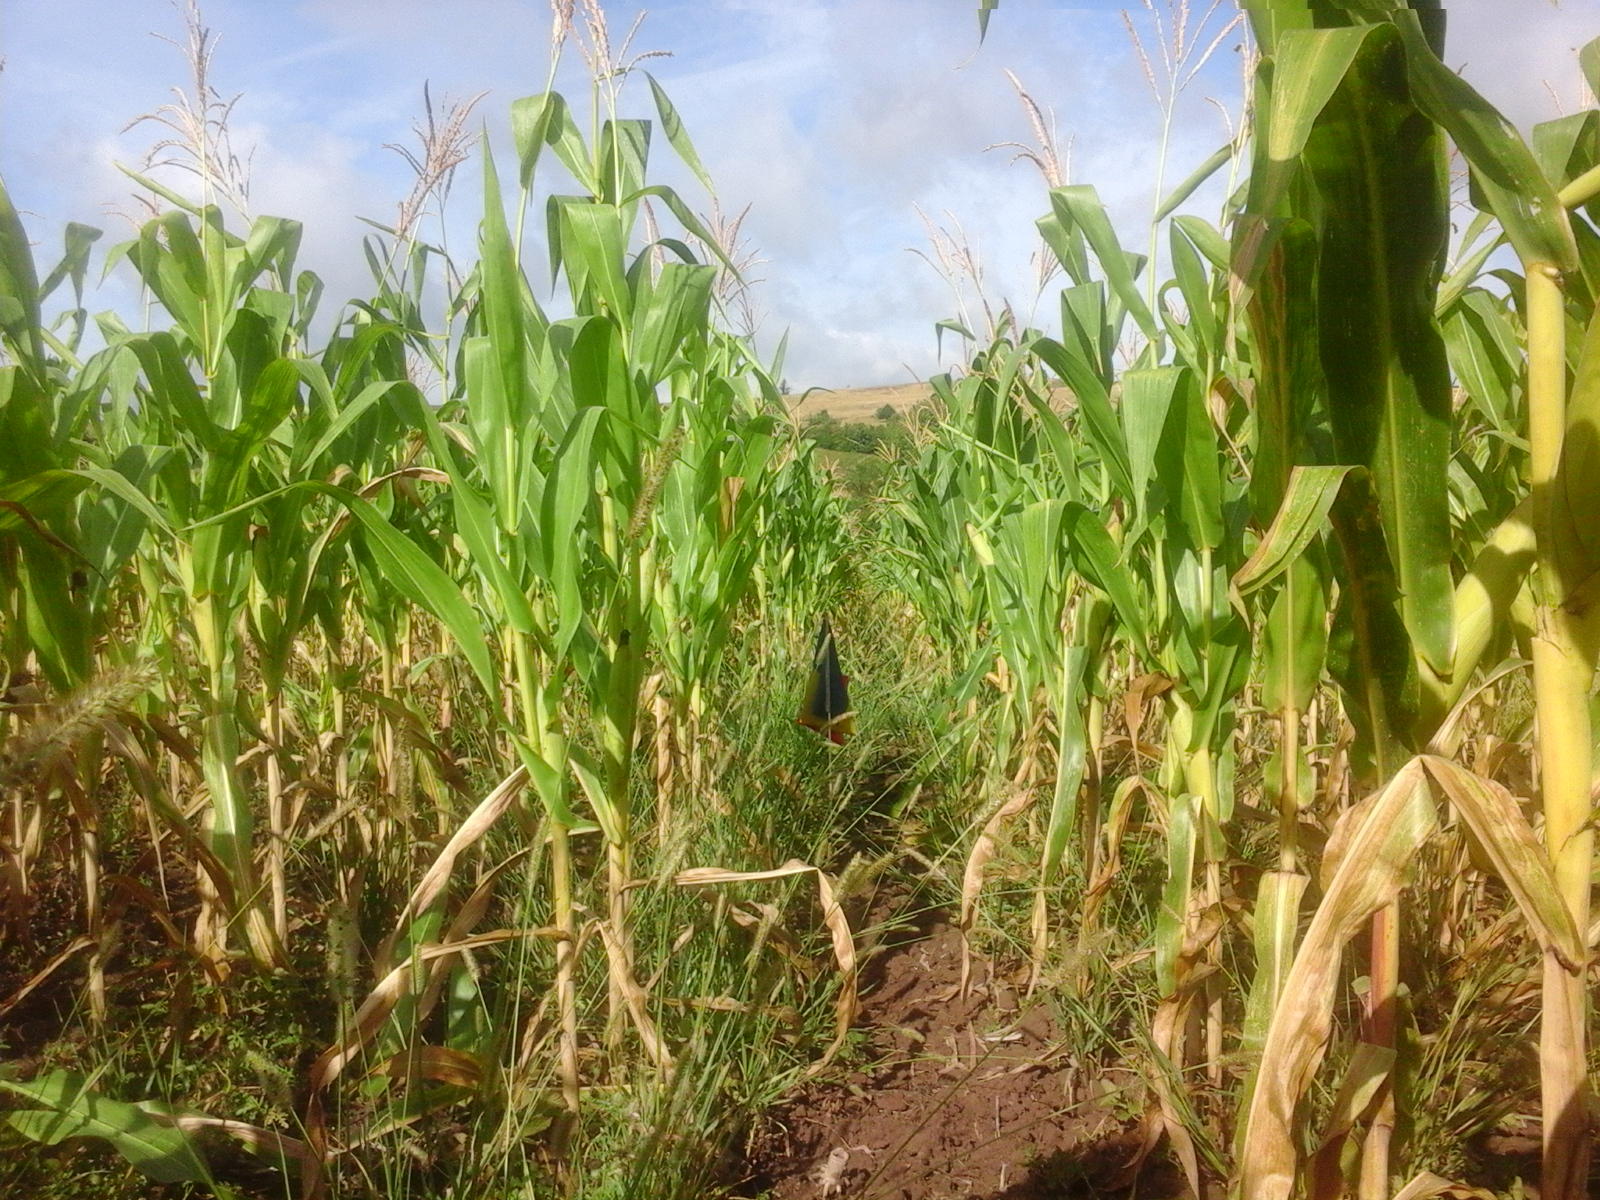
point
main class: Cropland
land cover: Maize
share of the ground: > 75 %
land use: Agriculture (excluding fallow land and kitchen gardens)
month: August
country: RO
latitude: 45.1872
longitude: 21.6265
